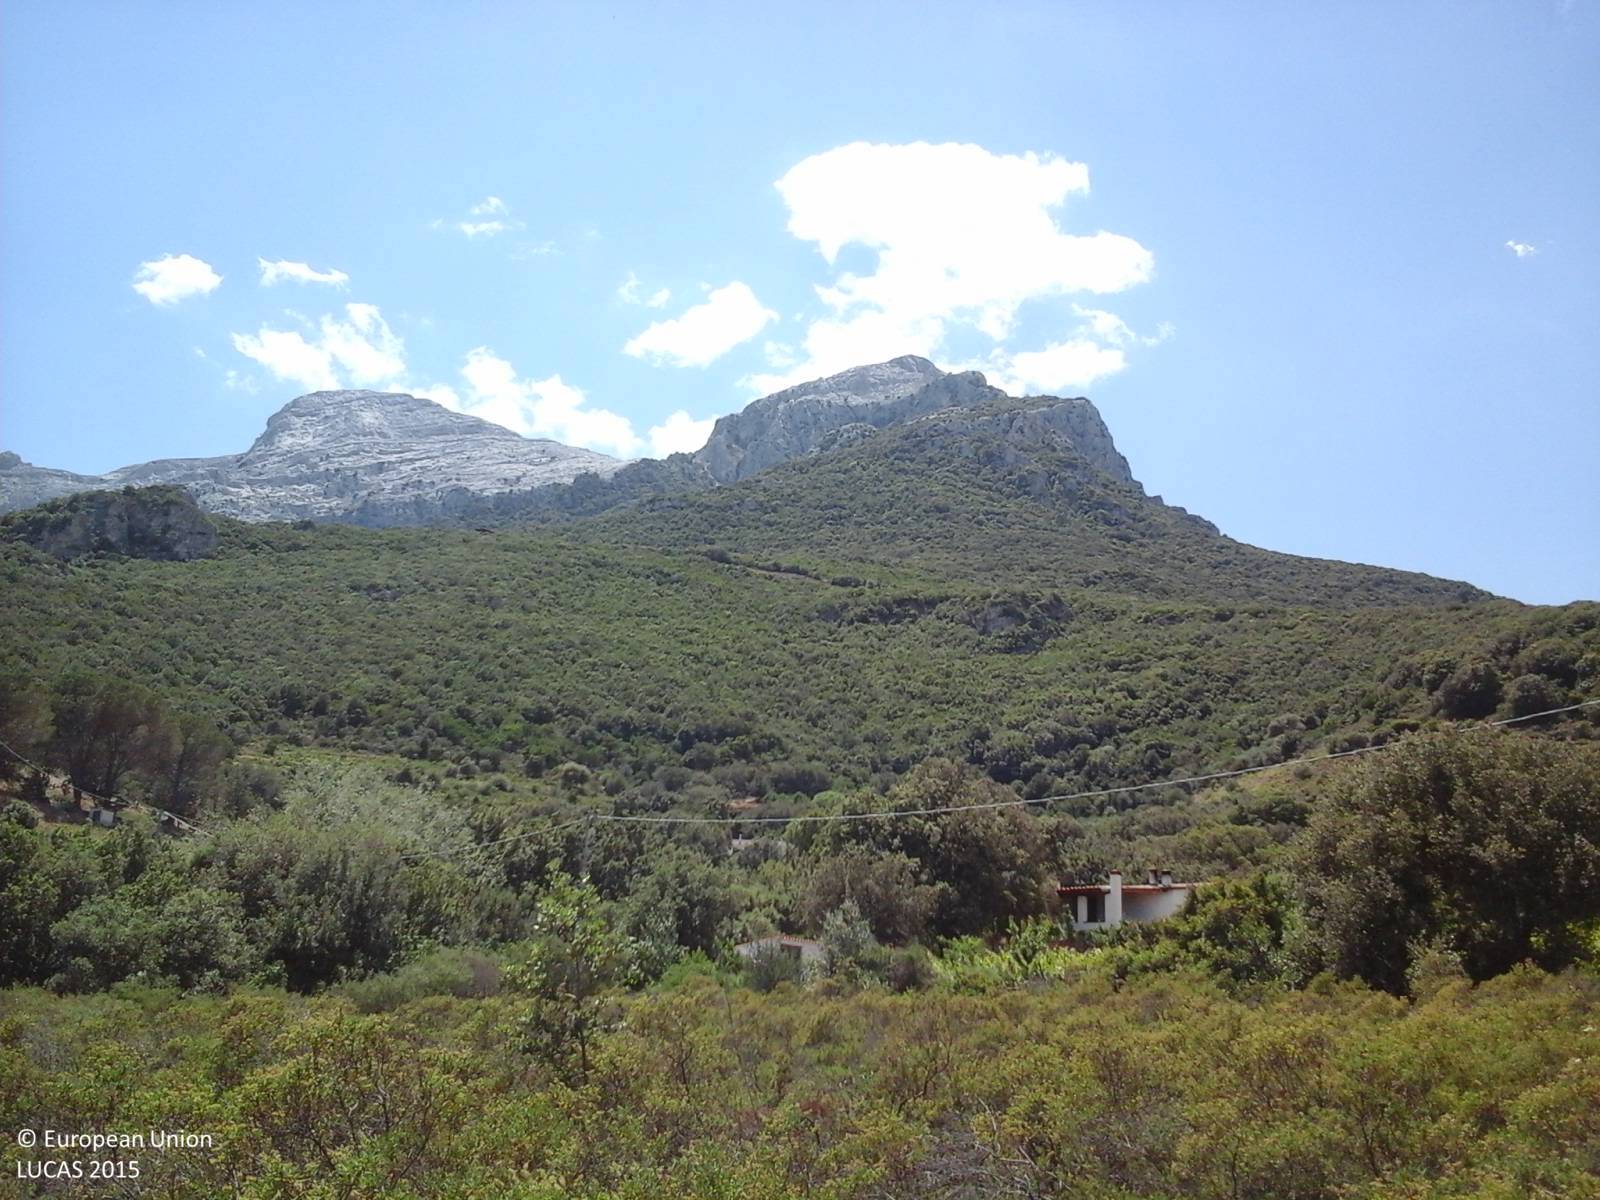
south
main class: Shrubland
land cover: Shrubland without tree cover
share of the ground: > 75 %
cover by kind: shrubs 95 %, unconsolidated bare surface 5 %
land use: Semi-natural and natural areas not in use
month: May
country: IT
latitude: 40.2838
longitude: 9.4267
